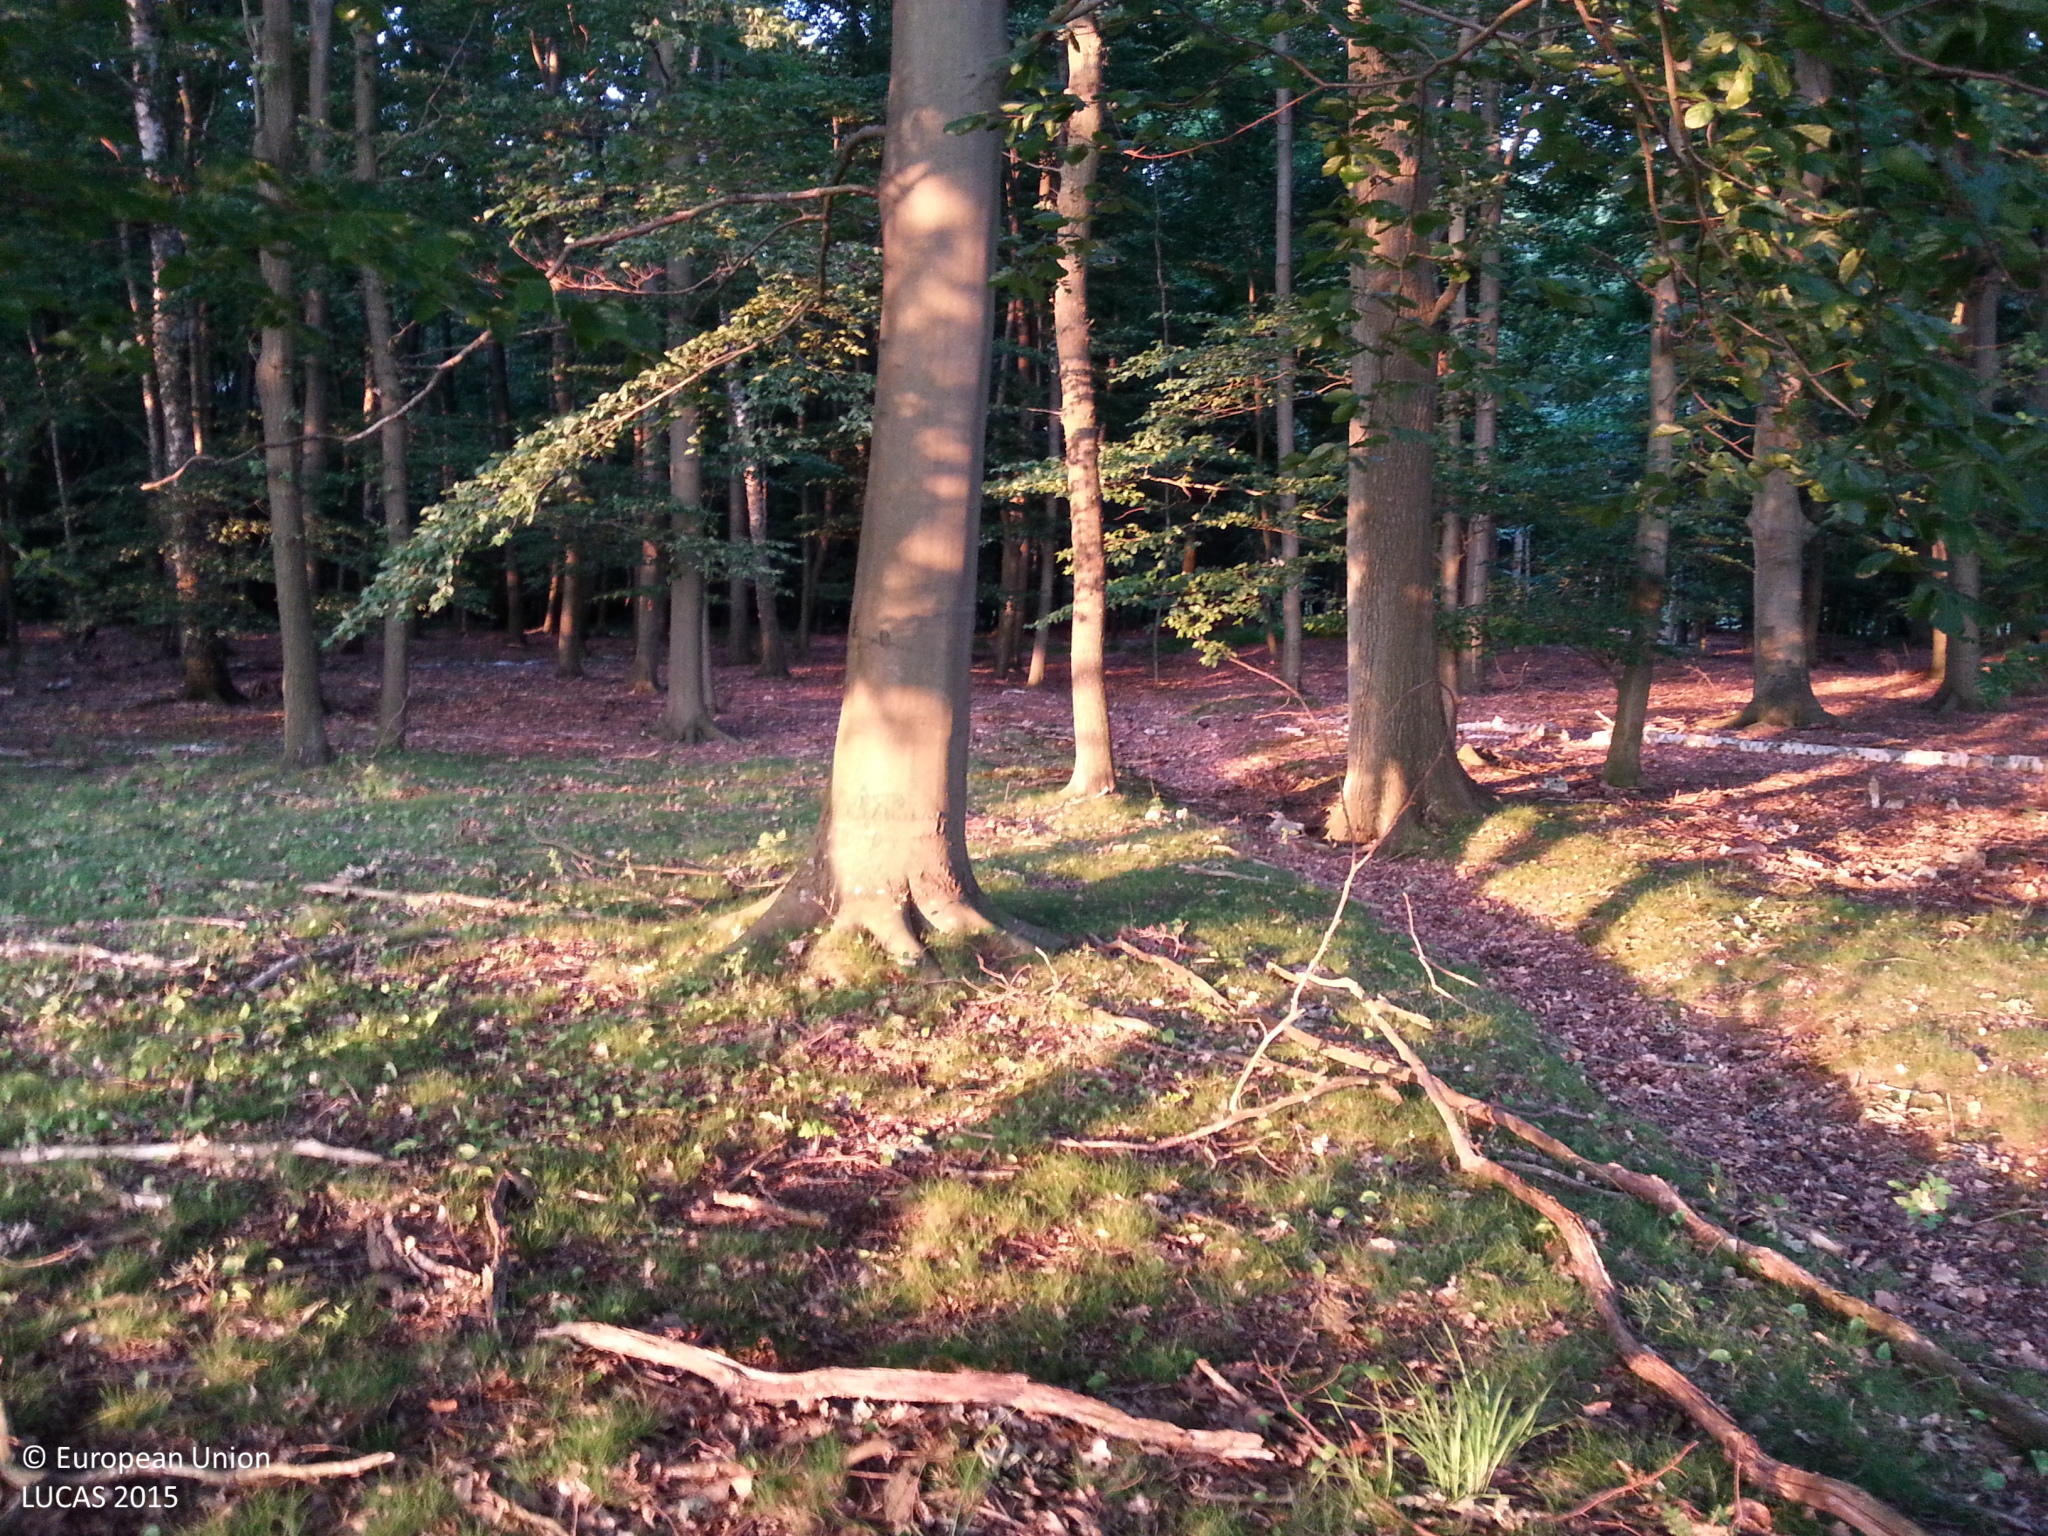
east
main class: Woodland
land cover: Broadleaved woodland
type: beech forest
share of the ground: > 75 %
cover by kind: broadleaved forest trees 90 %, unconsolidated bare surface 10 %
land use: Forestry
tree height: > 5 m
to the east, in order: Broadleaved woodland; Tracks; Broadleaved woodland
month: July
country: DE
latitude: 53.3425
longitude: 11.1560
